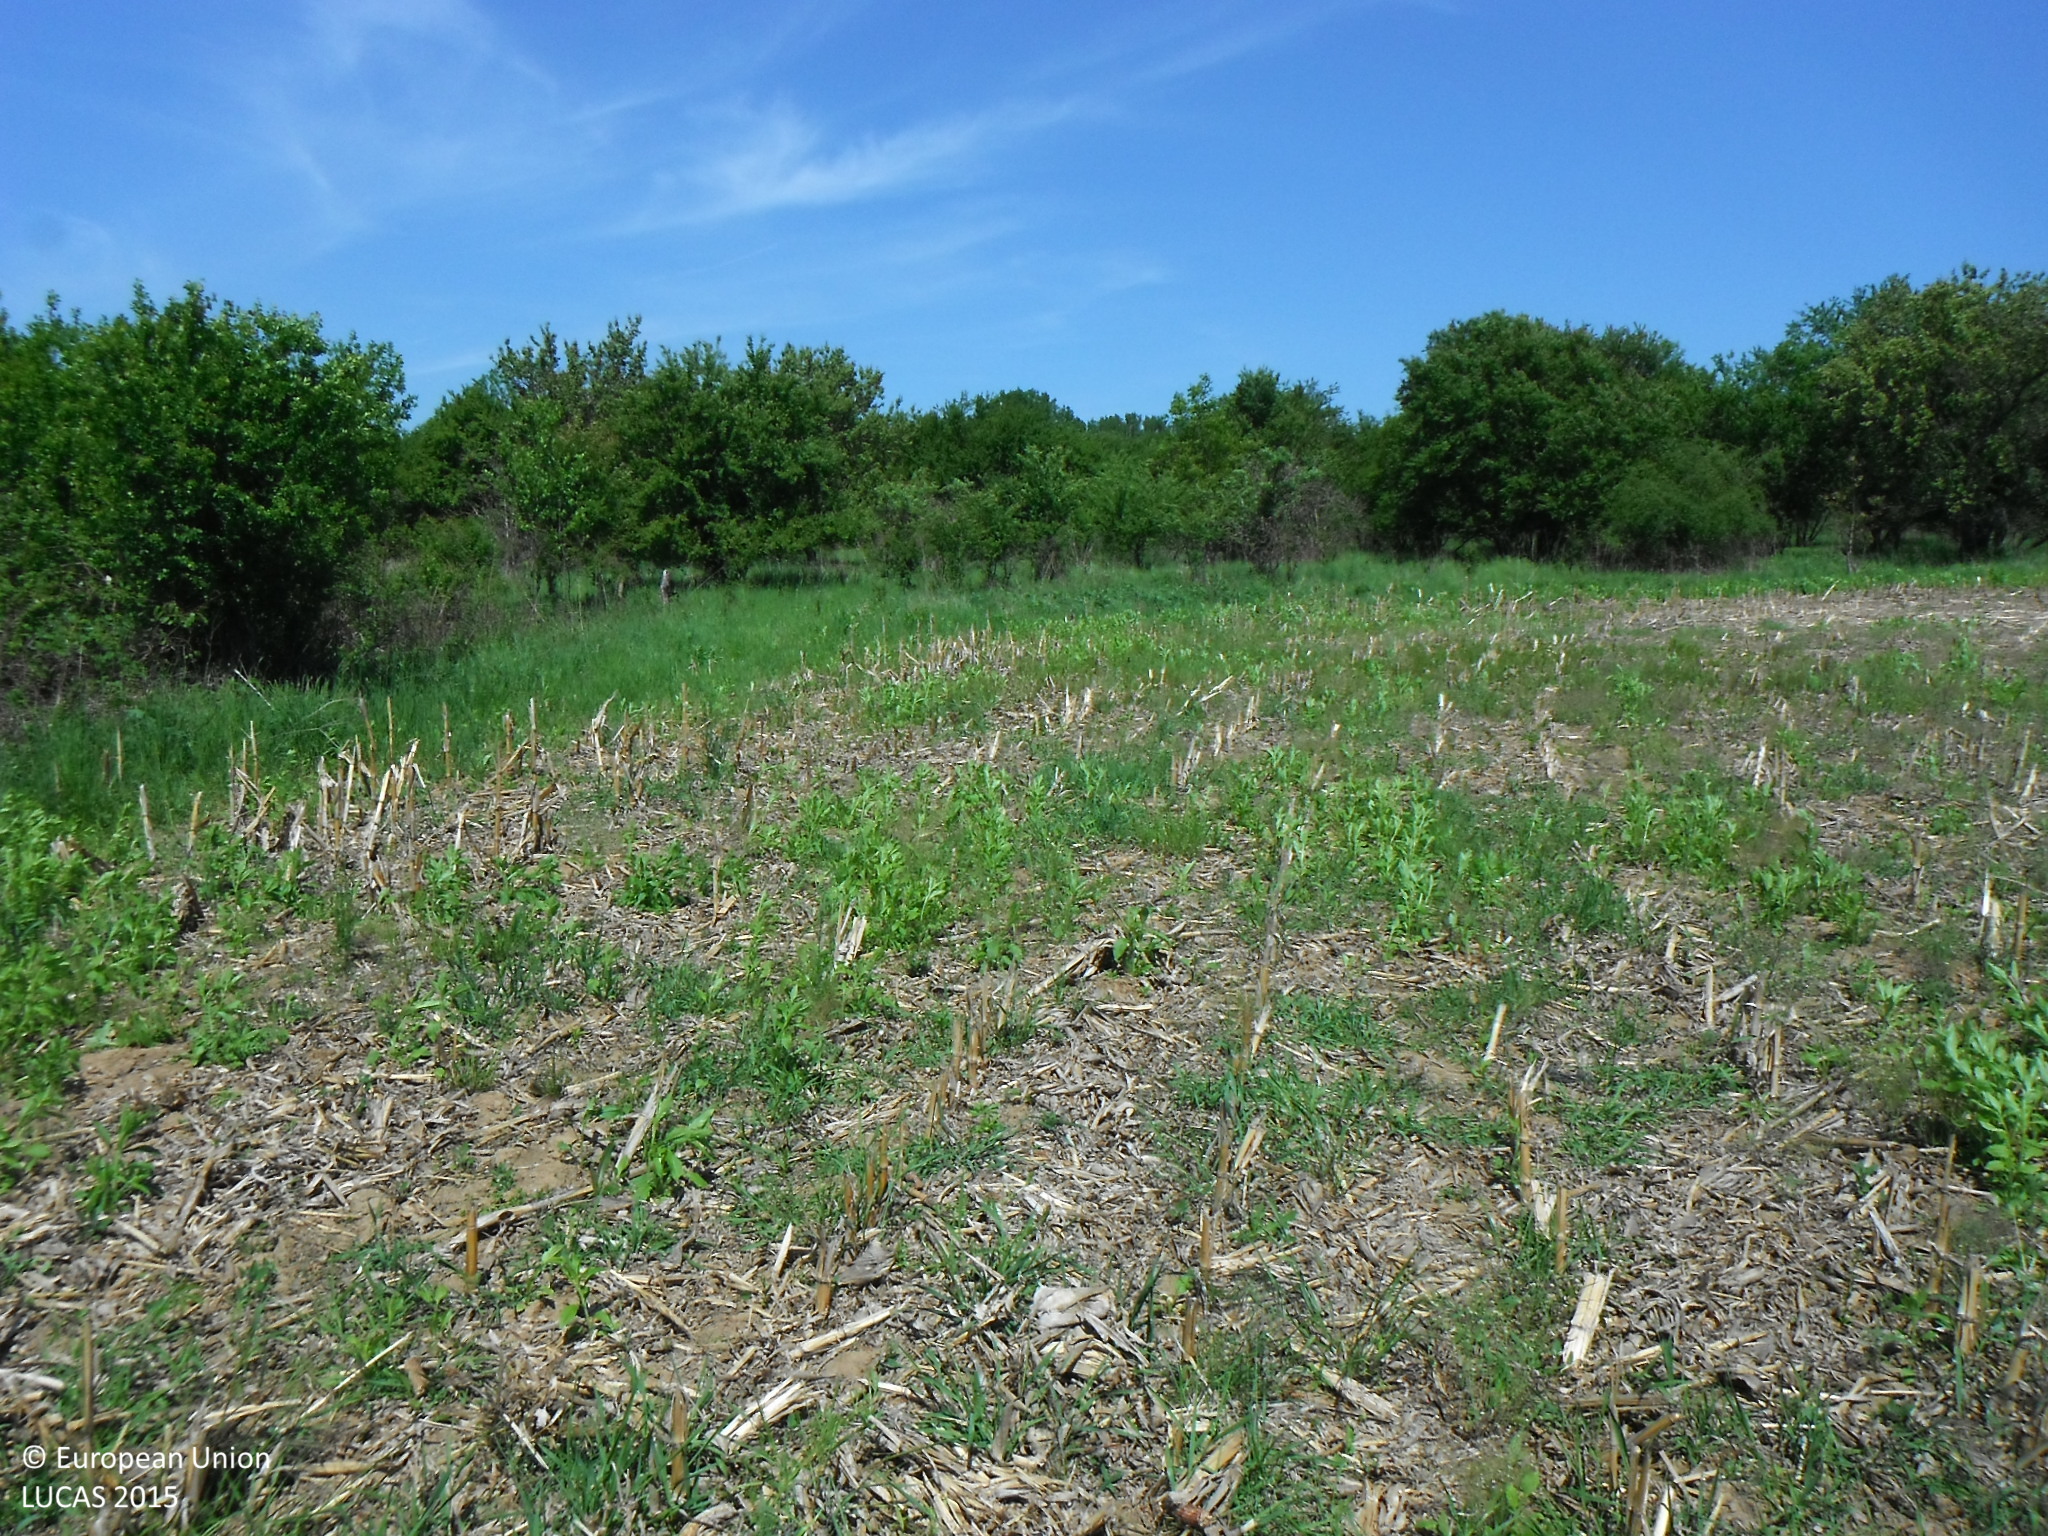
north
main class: Cropland
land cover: Maize
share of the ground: 25 - 50 %
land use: Fallow land
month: May
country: SK
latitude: 48.5691
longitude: 21.2791
